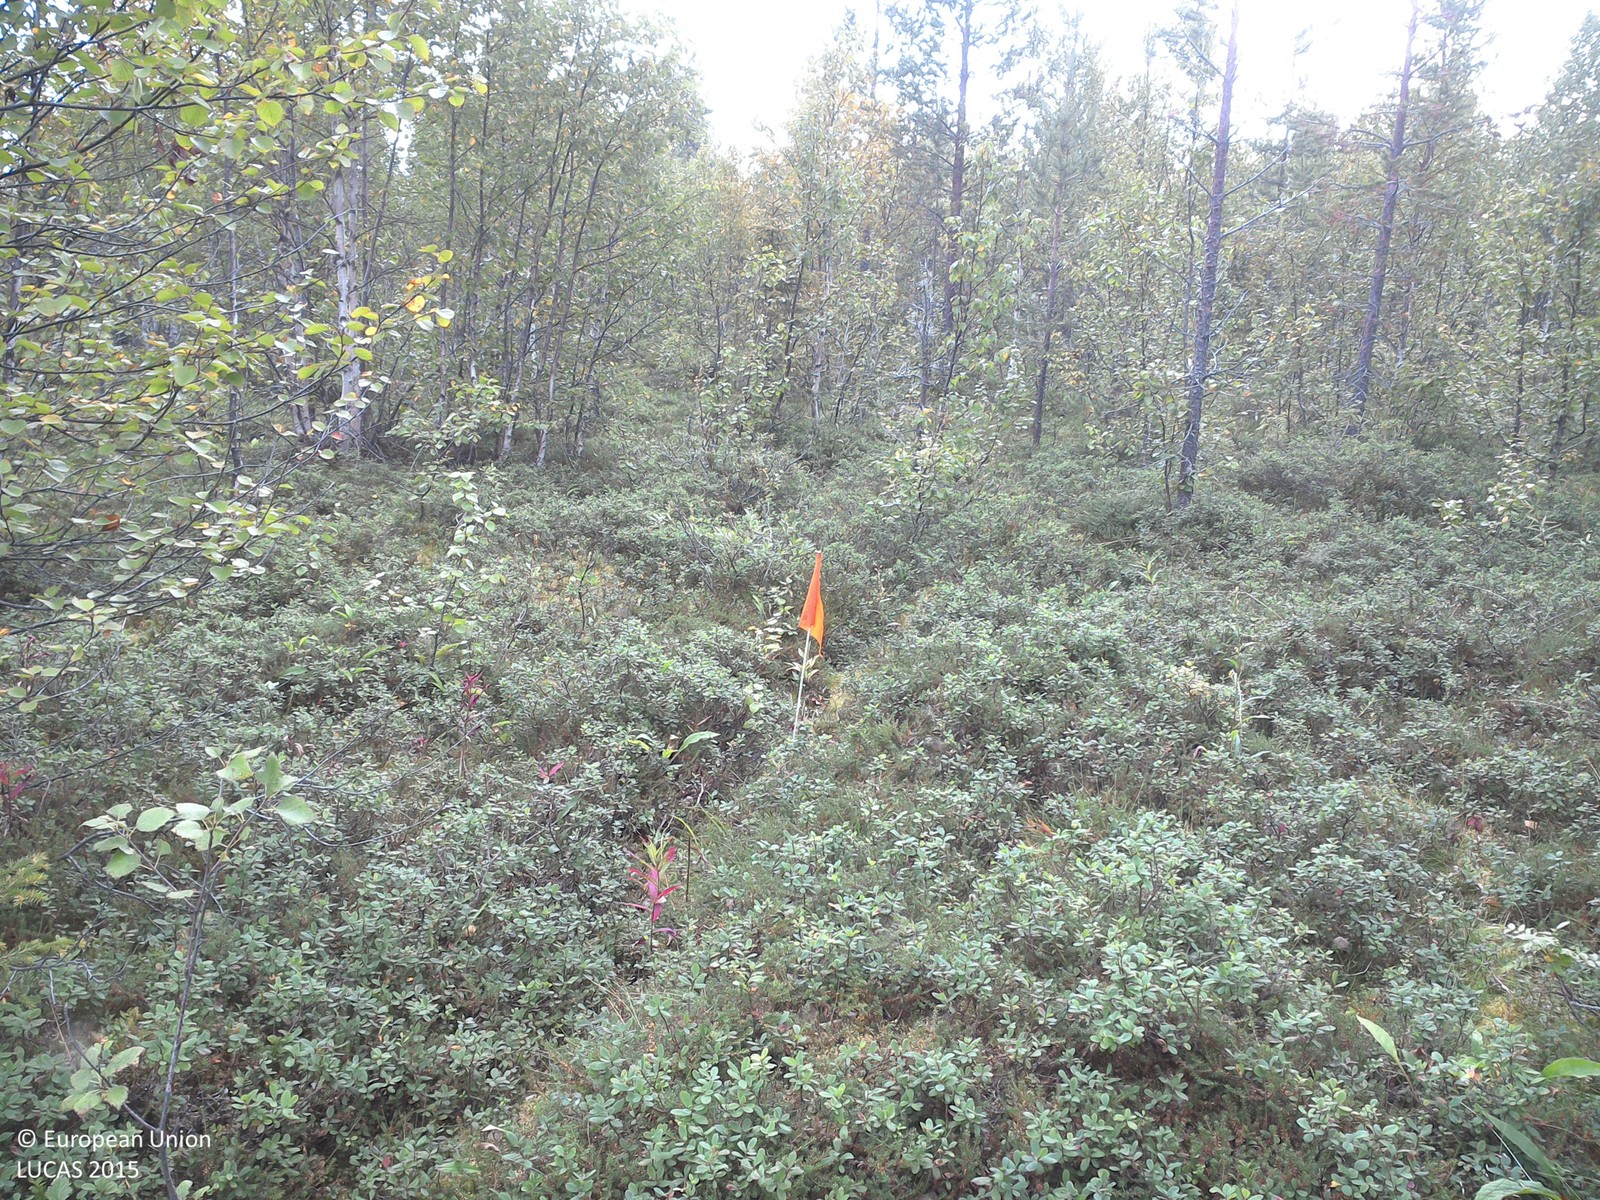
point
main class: Woodland
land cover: Other mixed woodland
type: boreal forest
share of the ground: 25 - 50 %
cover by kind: shrubs 65 %, broadleaved forest trees 20 %, coniferous forest trees 10 %, lichens and mosses 5 %
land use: Forestry
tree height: > 5 m
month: August
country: SE
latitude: 67.3410
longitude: 22.1689
